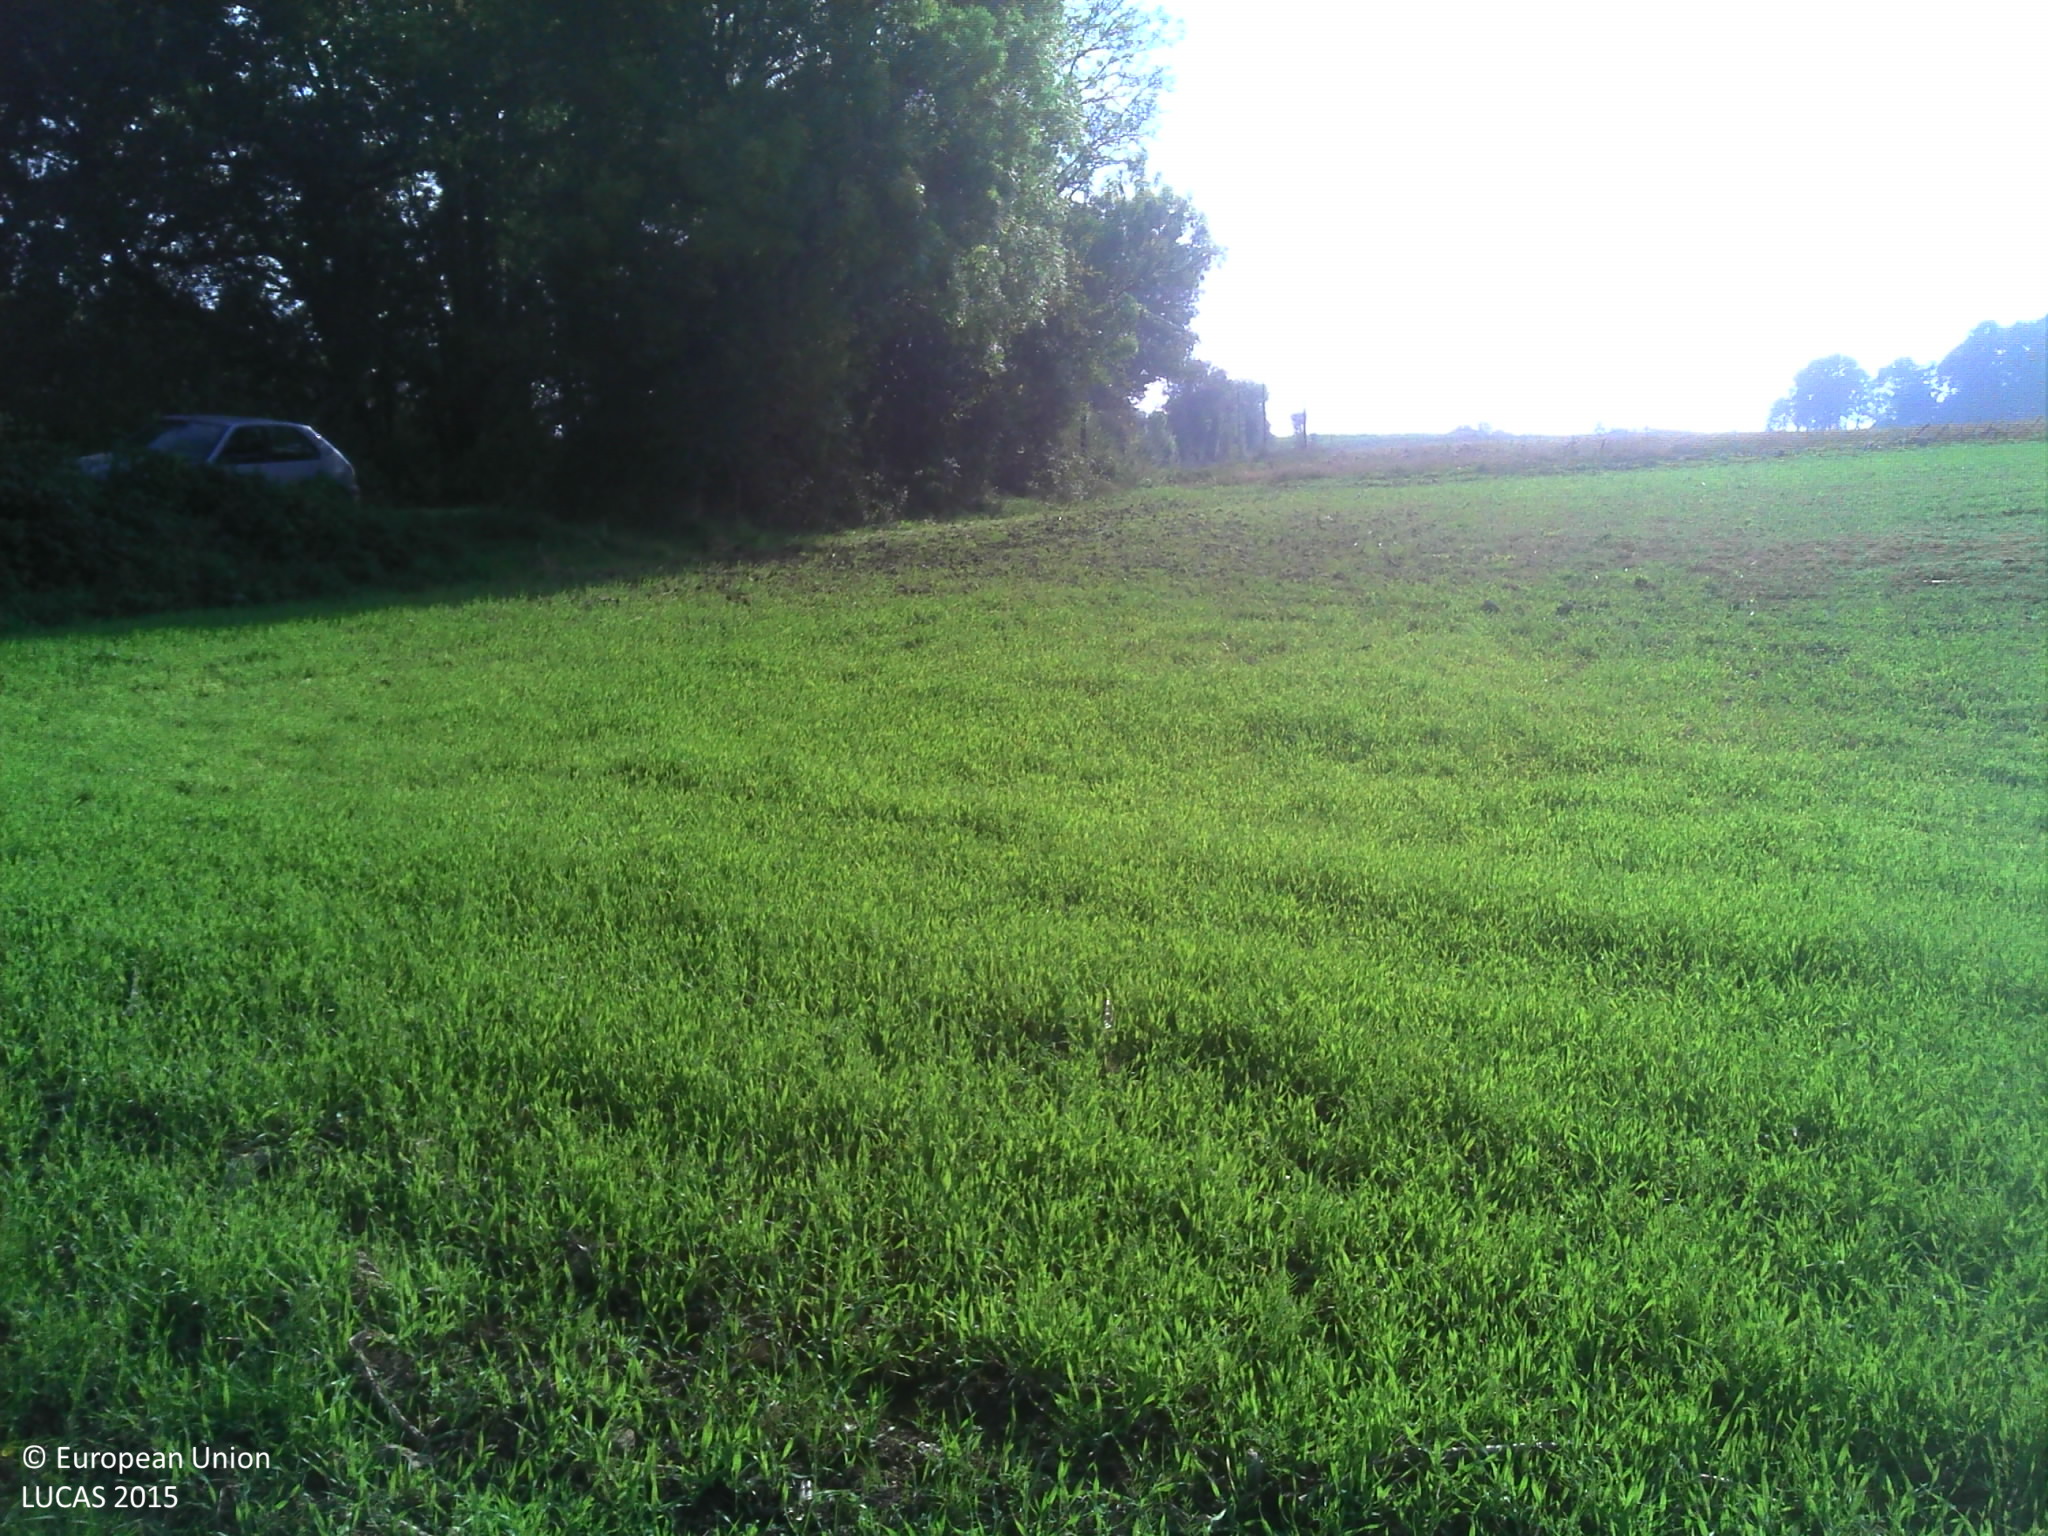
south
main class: Grassland
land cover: Grassland without tree/shrub cover
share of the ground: > 75 %
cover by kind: herbaceous plants 100 %
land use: Agriculture (excluding fallow land and kitchen gardens)
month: October
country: FR
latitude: 46.5077
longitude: -0.8337
